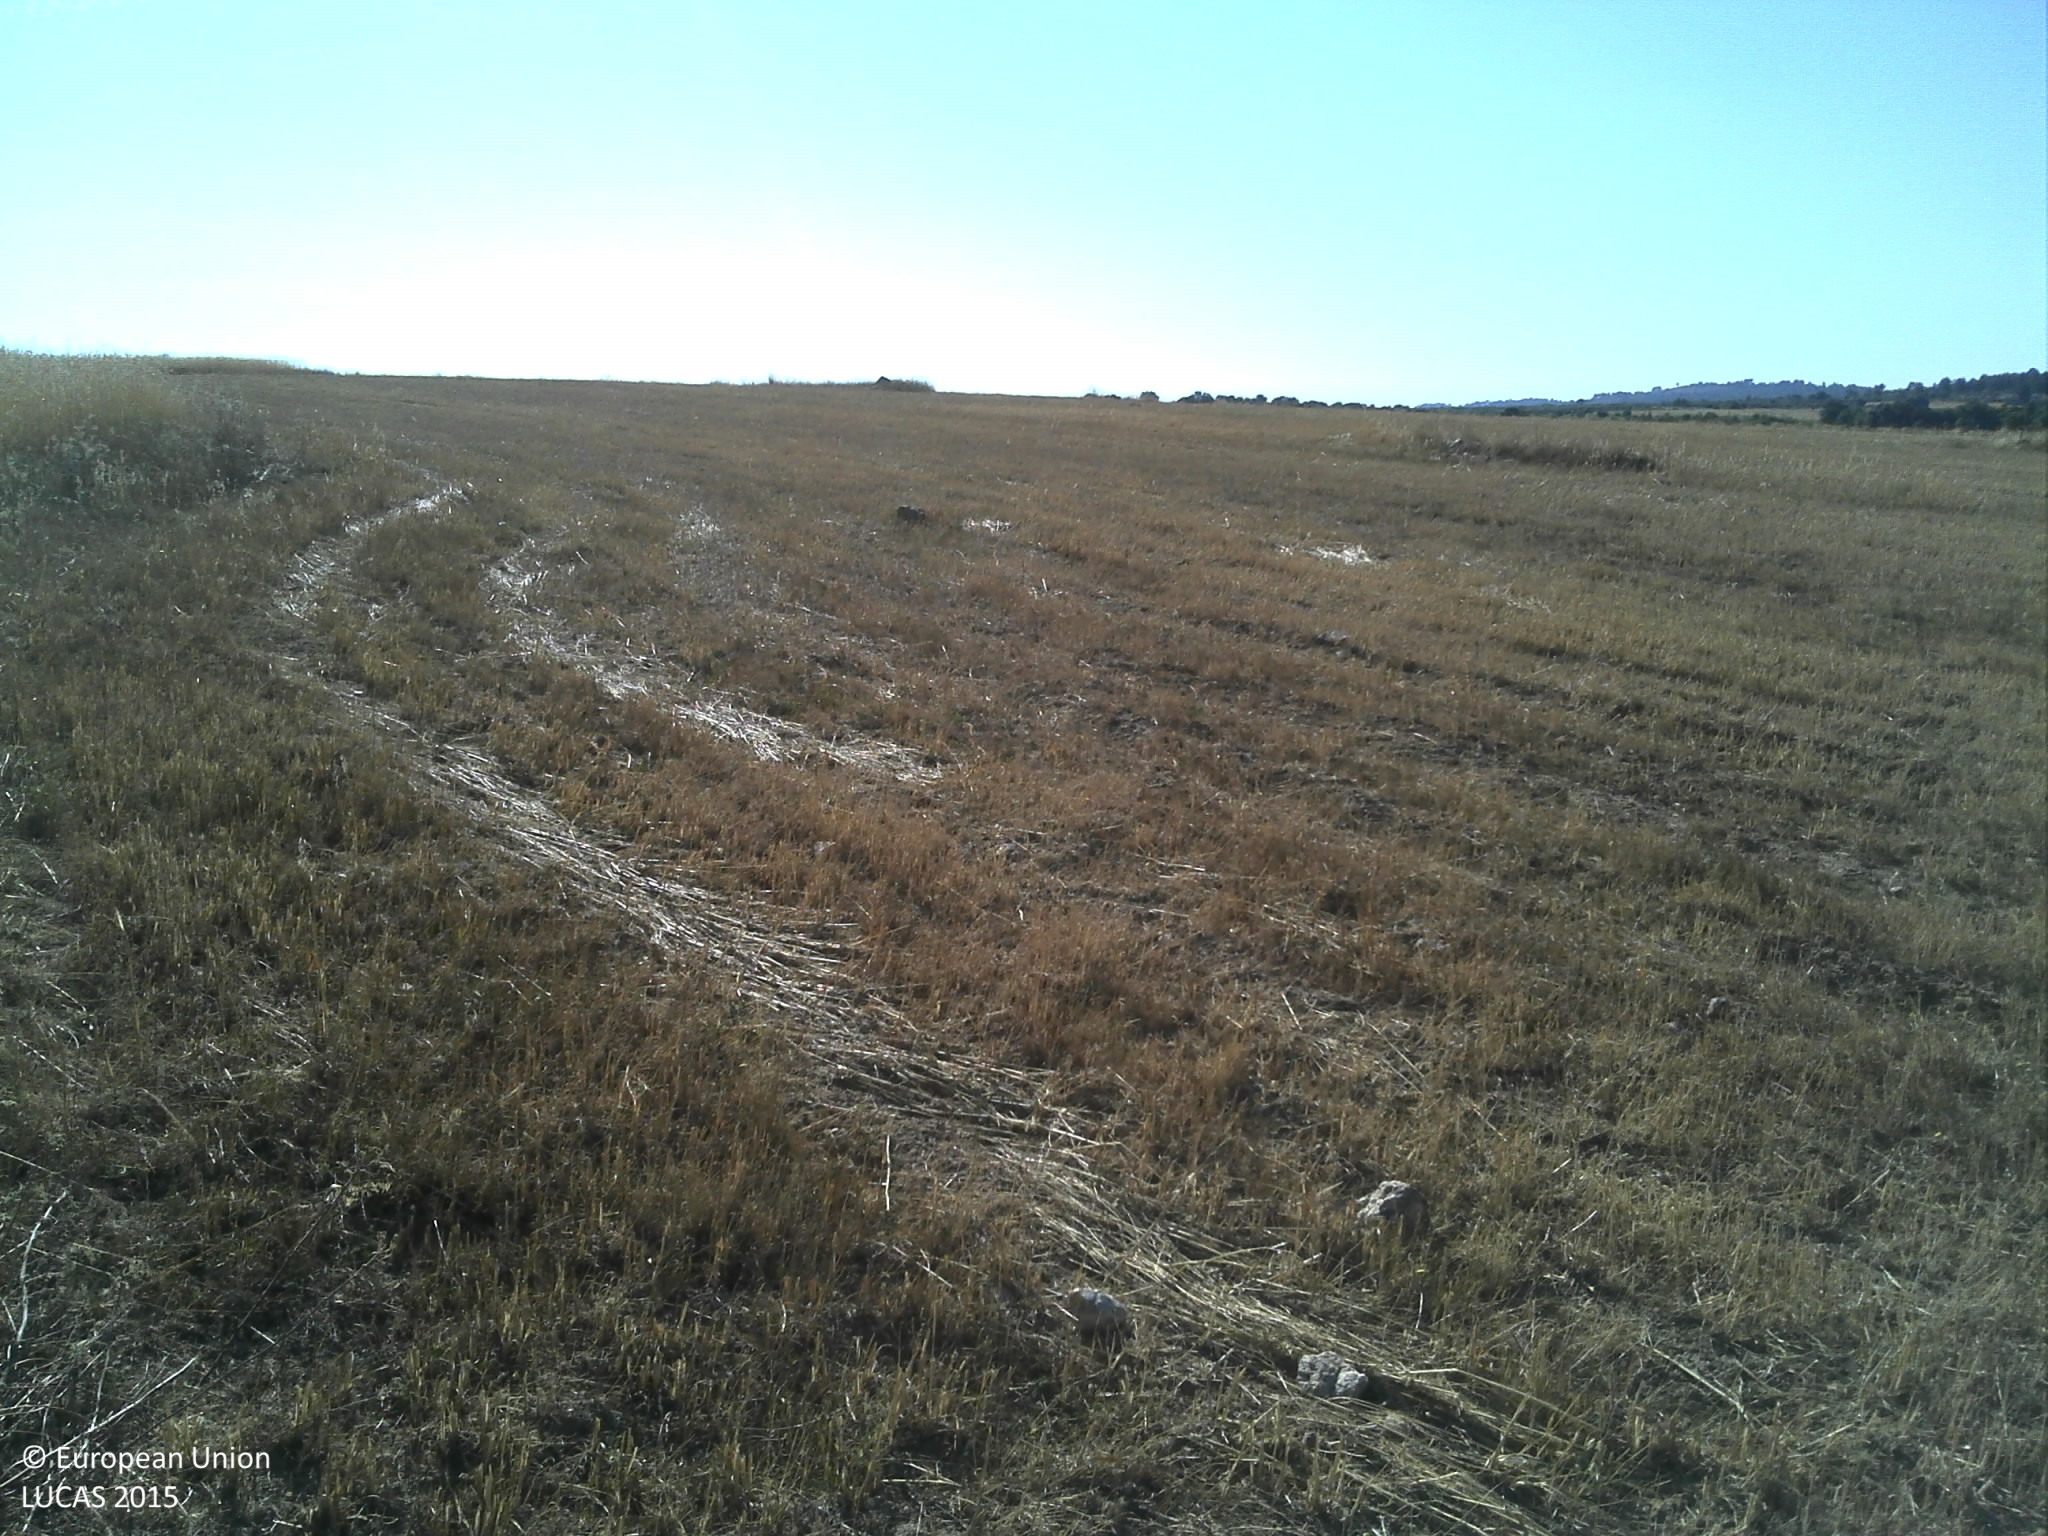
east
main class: Cropland
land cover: Barley
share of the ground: > 75 %
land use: Agriculture (excluding fallow land and kitchen gardens)
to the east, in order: Barley; Grass margins; Oats; Barley; Grass margins; Oats
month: June
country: PT
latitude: 40.8907
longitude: -6.8972
